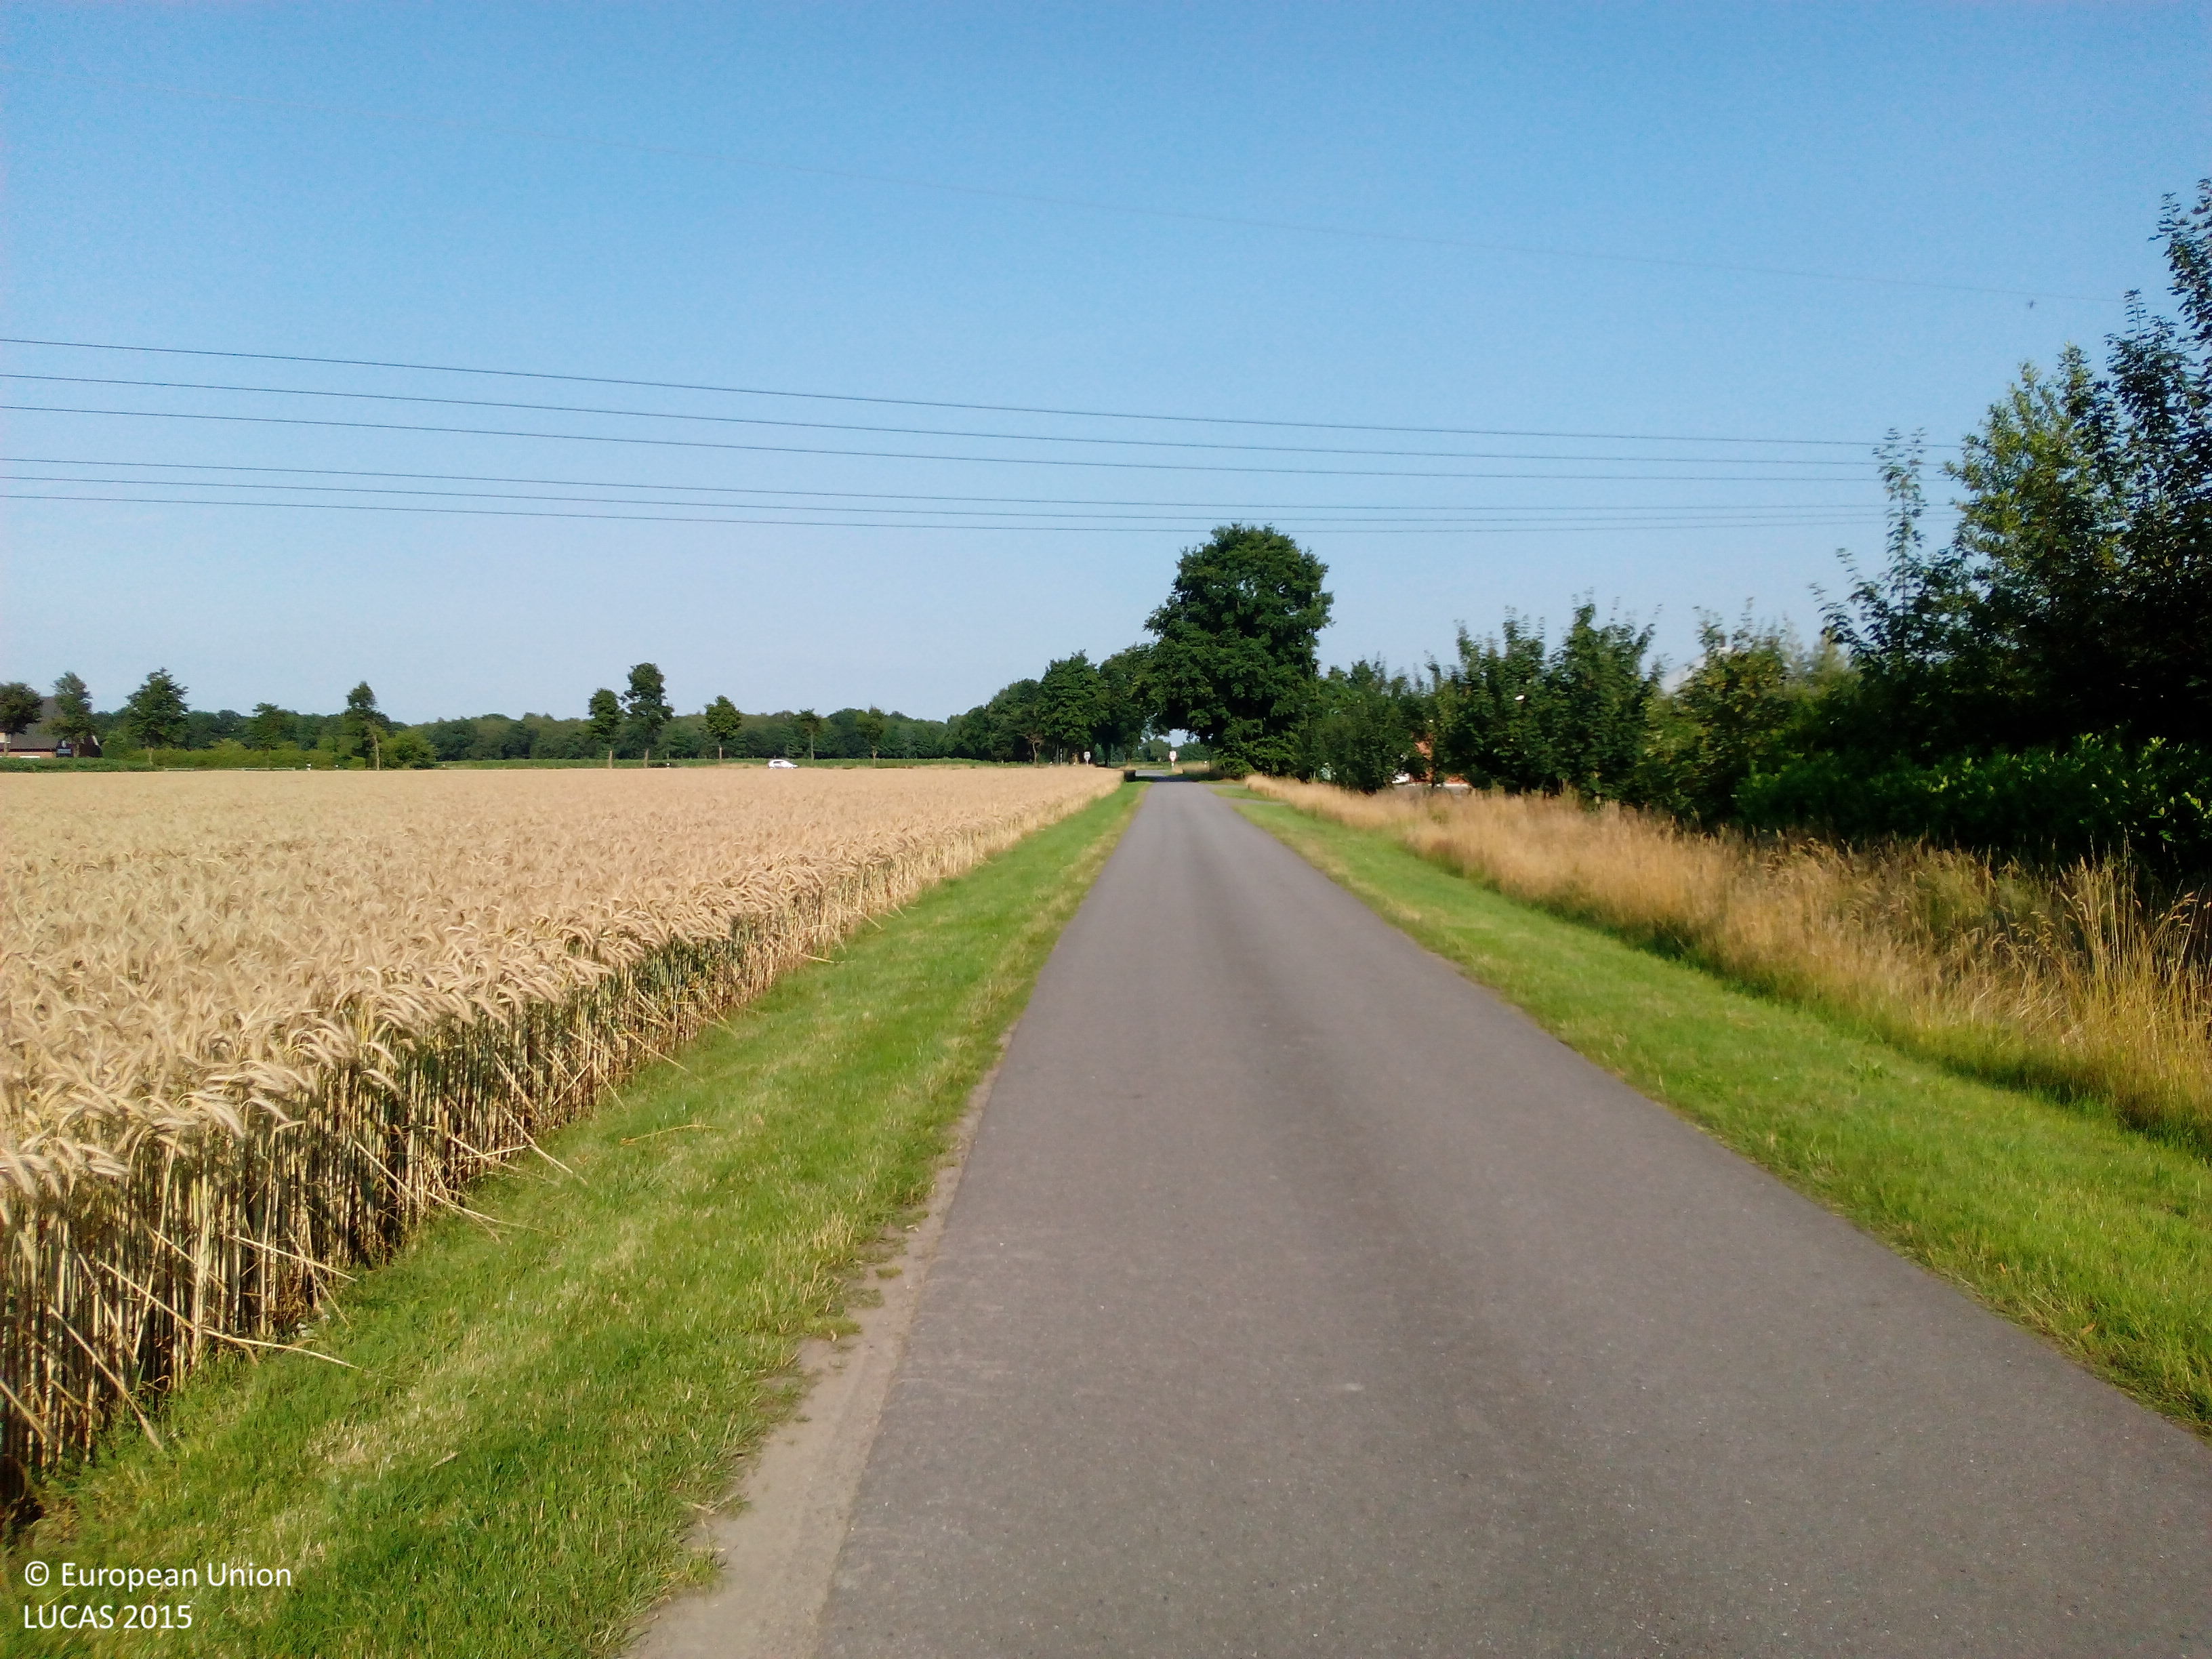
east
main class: Cropland
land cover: Barley
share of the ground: > 75 %
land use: Agriculture (excluding fallow land and kitchen gardens)
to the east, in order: Barley; Electric lines; Barley; Lines of trees; Paved roads, cycling and walking lanes; Grass margins; Paved roads, cycling and walking lanes; Shruby margins; Ditches and canals; Shruby margins; Maize
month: July
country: DE
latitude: 52.4857
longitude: 7.9536
